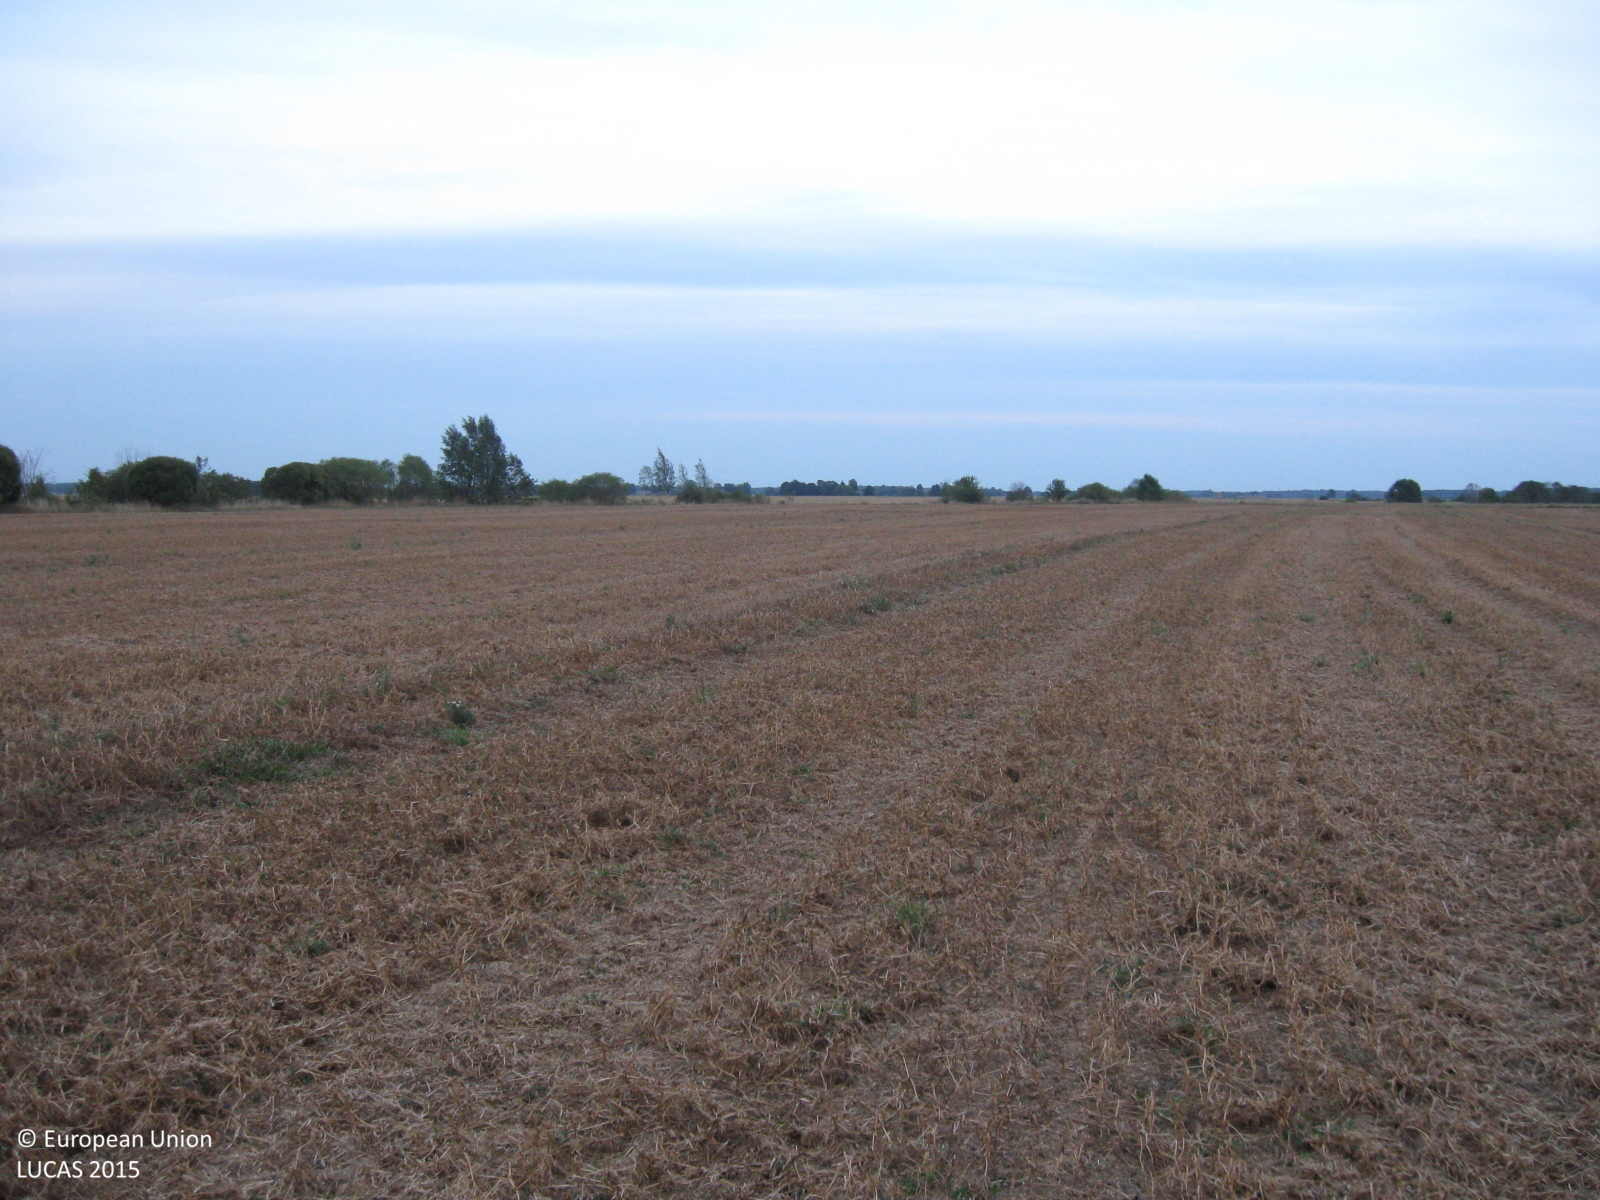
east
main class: Cropland
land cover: Dry pulses
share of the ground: 10 - 25 %
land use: Agriculture (excluding fallow land and kitchen gardens)
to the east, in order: Dry pulses; Shruby margins; Abandoned hedges; Ditches and canals; Abandoned hedges; Tracks; Grass margins; Common wheat
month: August
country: LT
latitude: 55.1816
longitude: 23.1230
